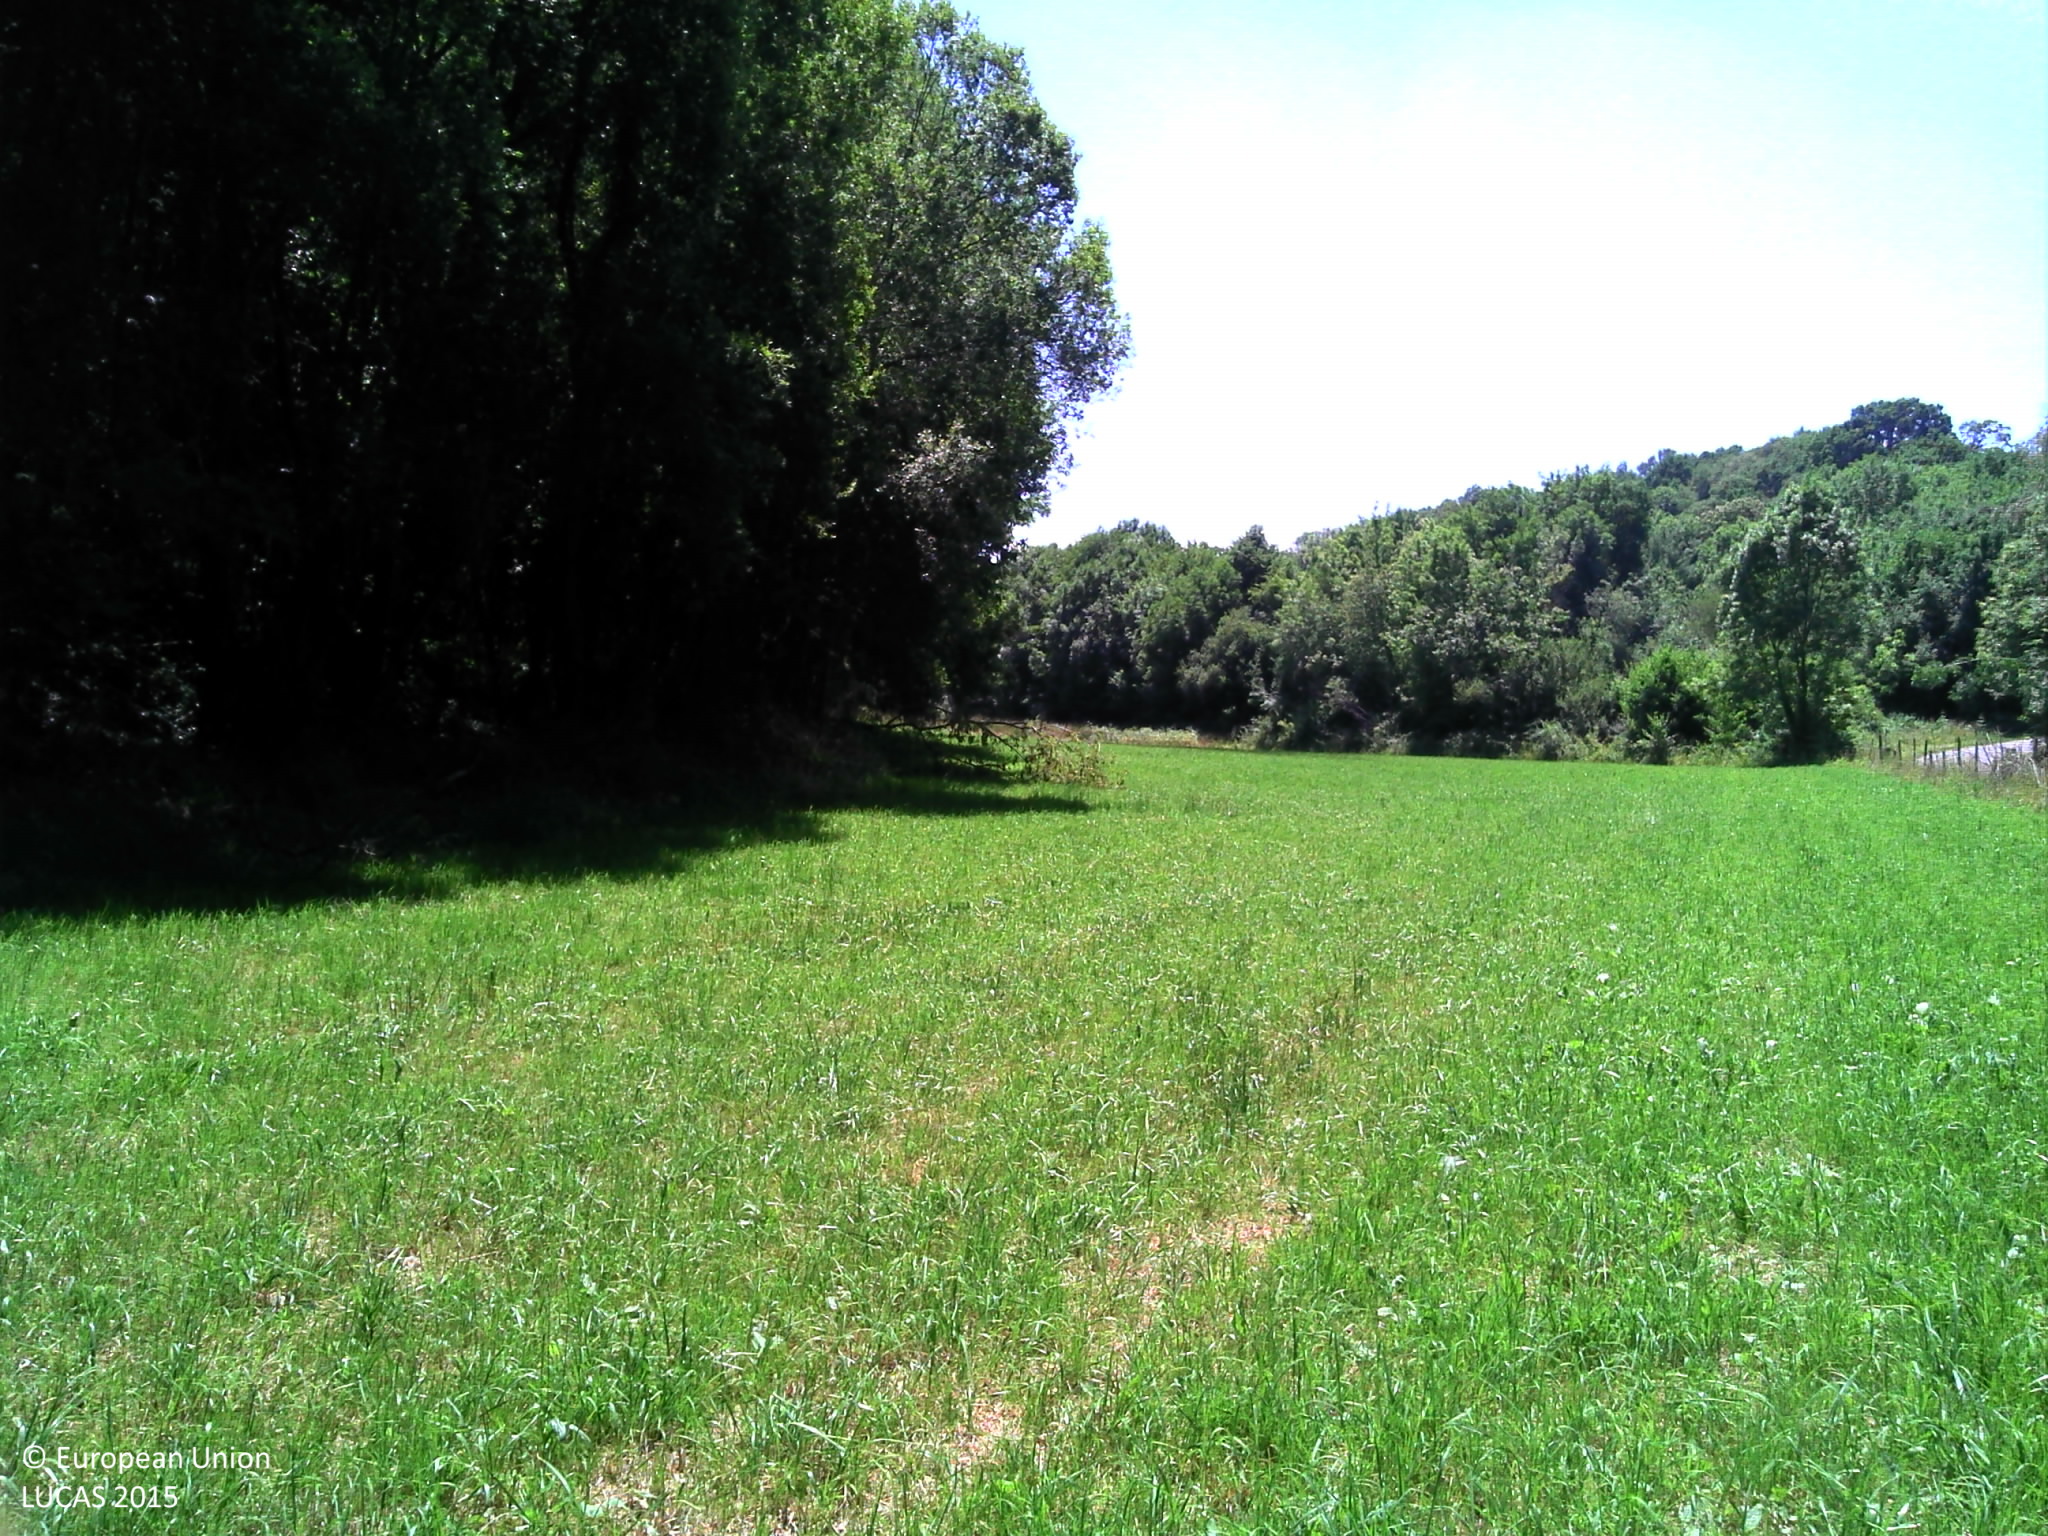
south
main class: Cropland
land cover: Temporary grasslands
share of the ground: > 75 %
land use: Agriculture (excluding fallow land and kitchen gardens)
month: June
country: FR
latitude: 43.1635
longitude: -0.1264
